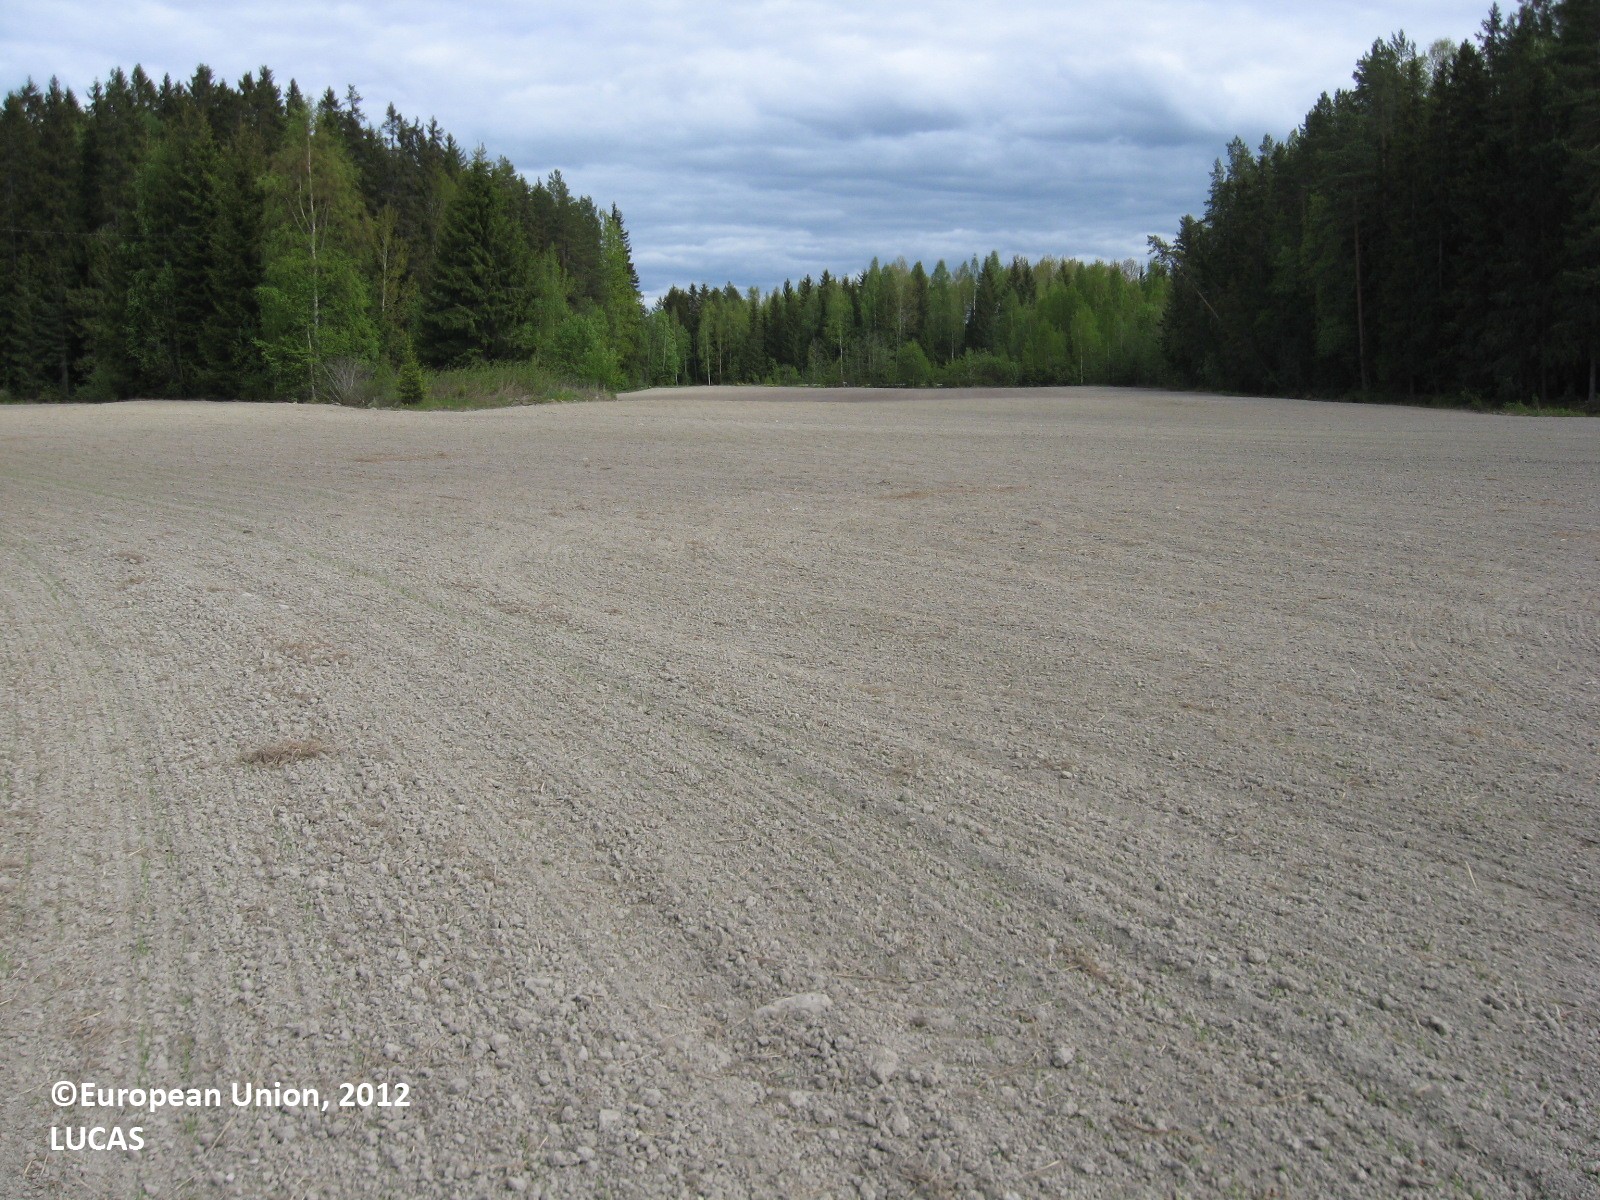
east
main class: Cropland
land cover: Barley
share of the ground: < 10 %
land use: Agriculture (excluding fallow land and kitchen gardens)
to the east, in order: Barley; Ditches and canals; Lines of trees; Grass margins; Oats; Ditches and canals; Spruce dominated mixed woodland
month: May
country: FI
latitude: 61.8347
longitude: 22.6928
